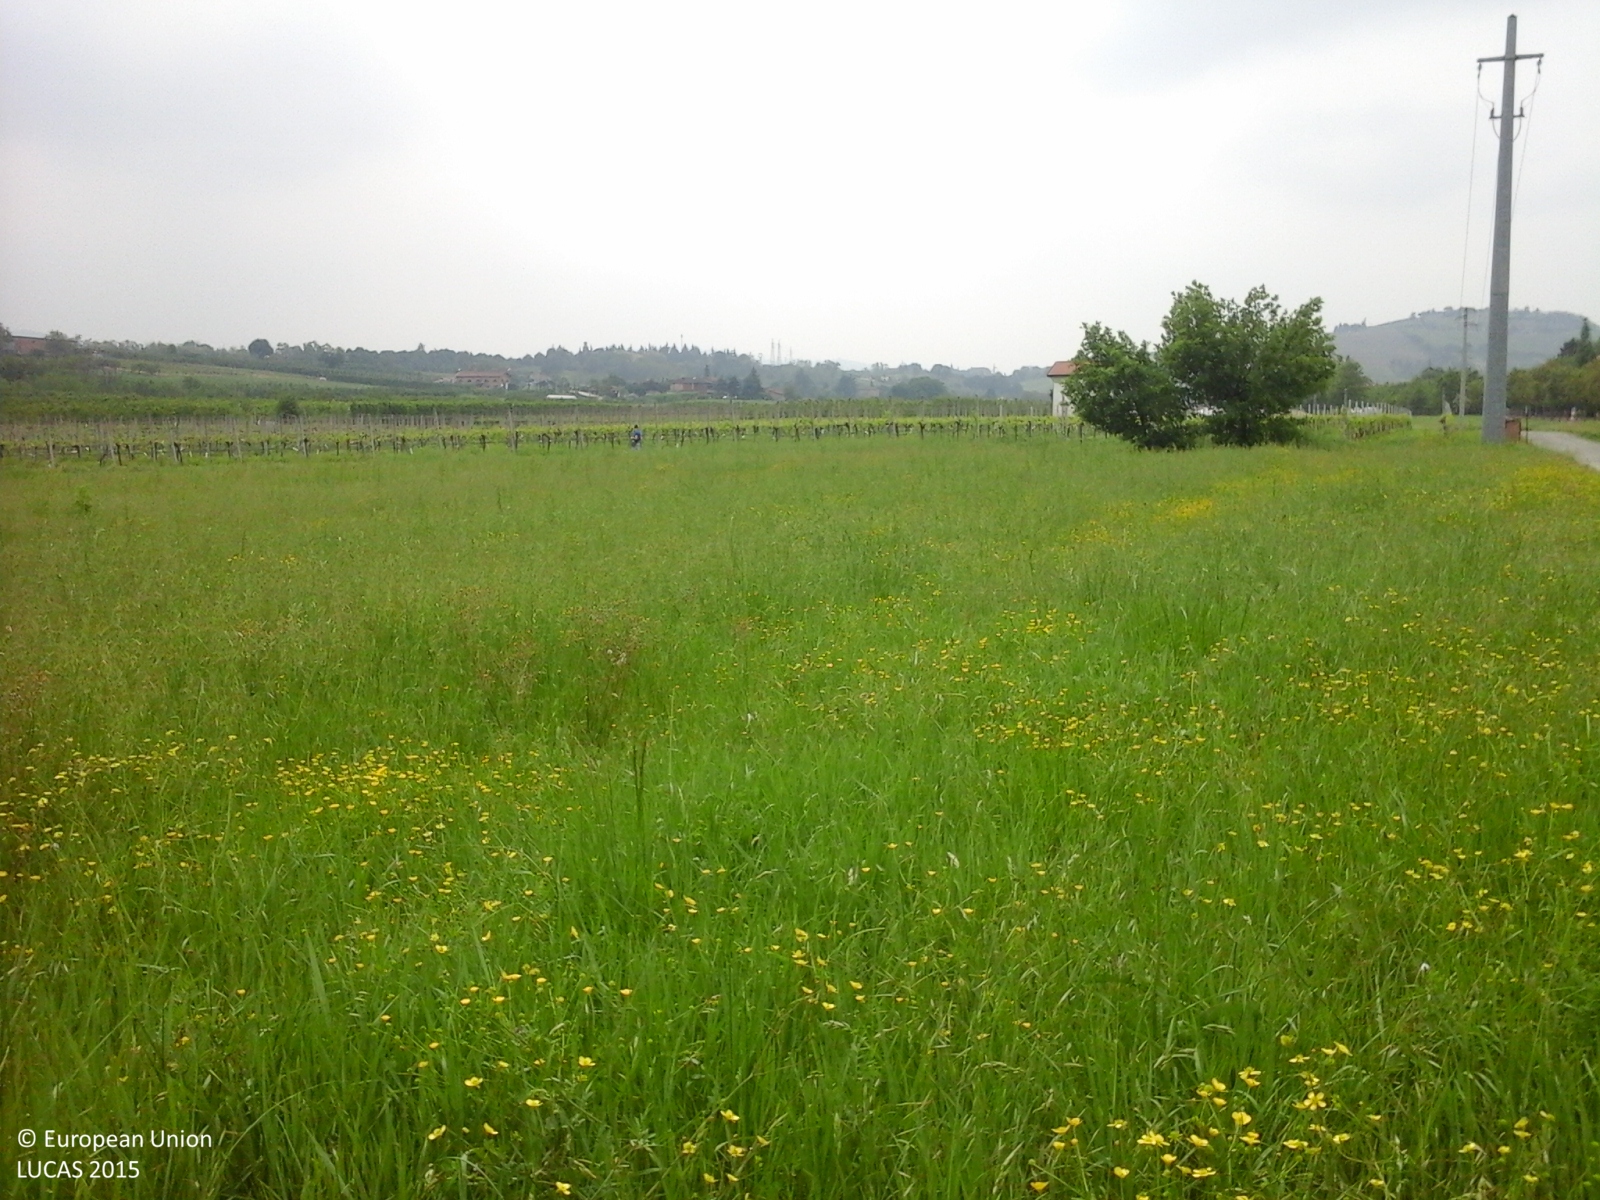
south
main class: Grassland
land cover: Grassland without tree/shrub cover
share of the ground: > 75 %
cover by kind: herbaceous plants 100 %
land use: Agriculture (excluding fallow land and kitchen gardens)
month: May
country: IT
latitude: 44.4901
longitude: 10.9912
